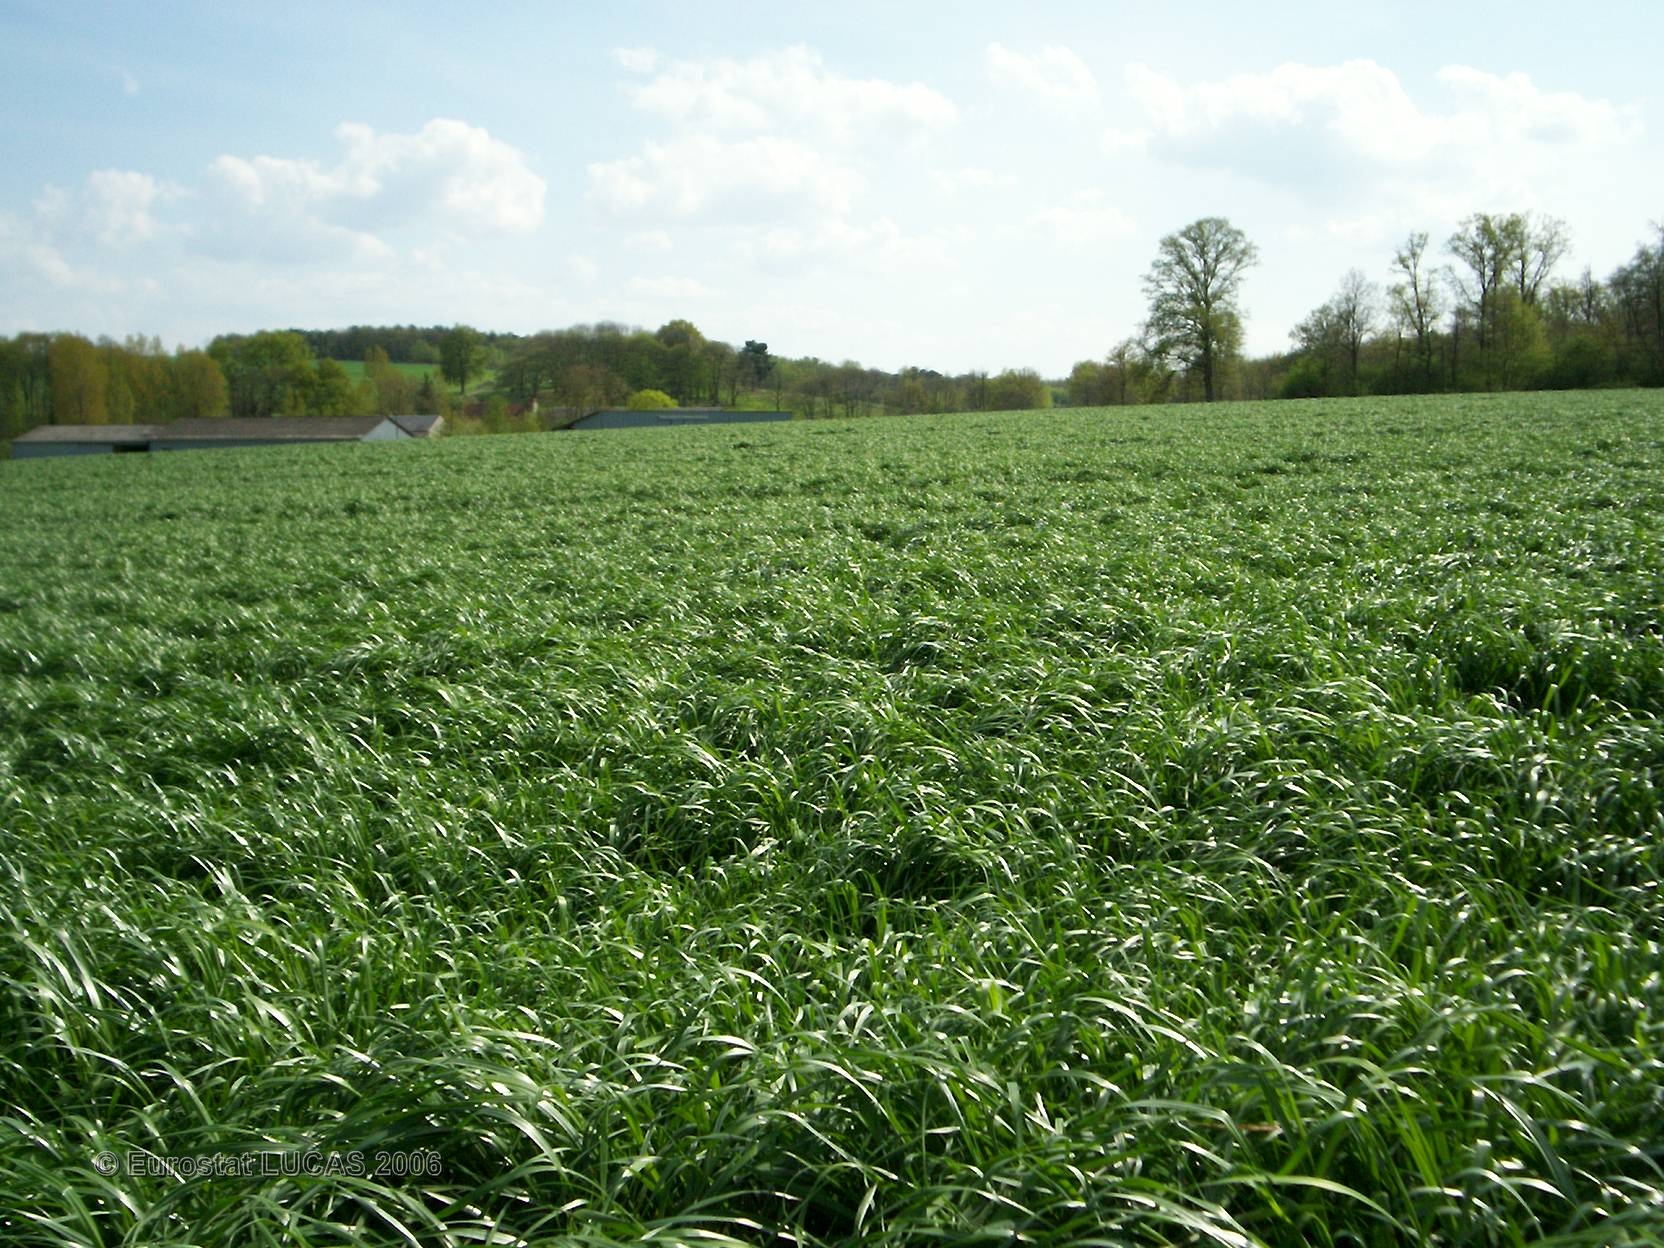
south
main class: Grassland
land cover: Grassland without tree/shrub cover
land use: Agriculture (excluding fallow land and kitchen gardens)
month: April
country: FR
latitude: 46.9256
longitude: 0.5120
